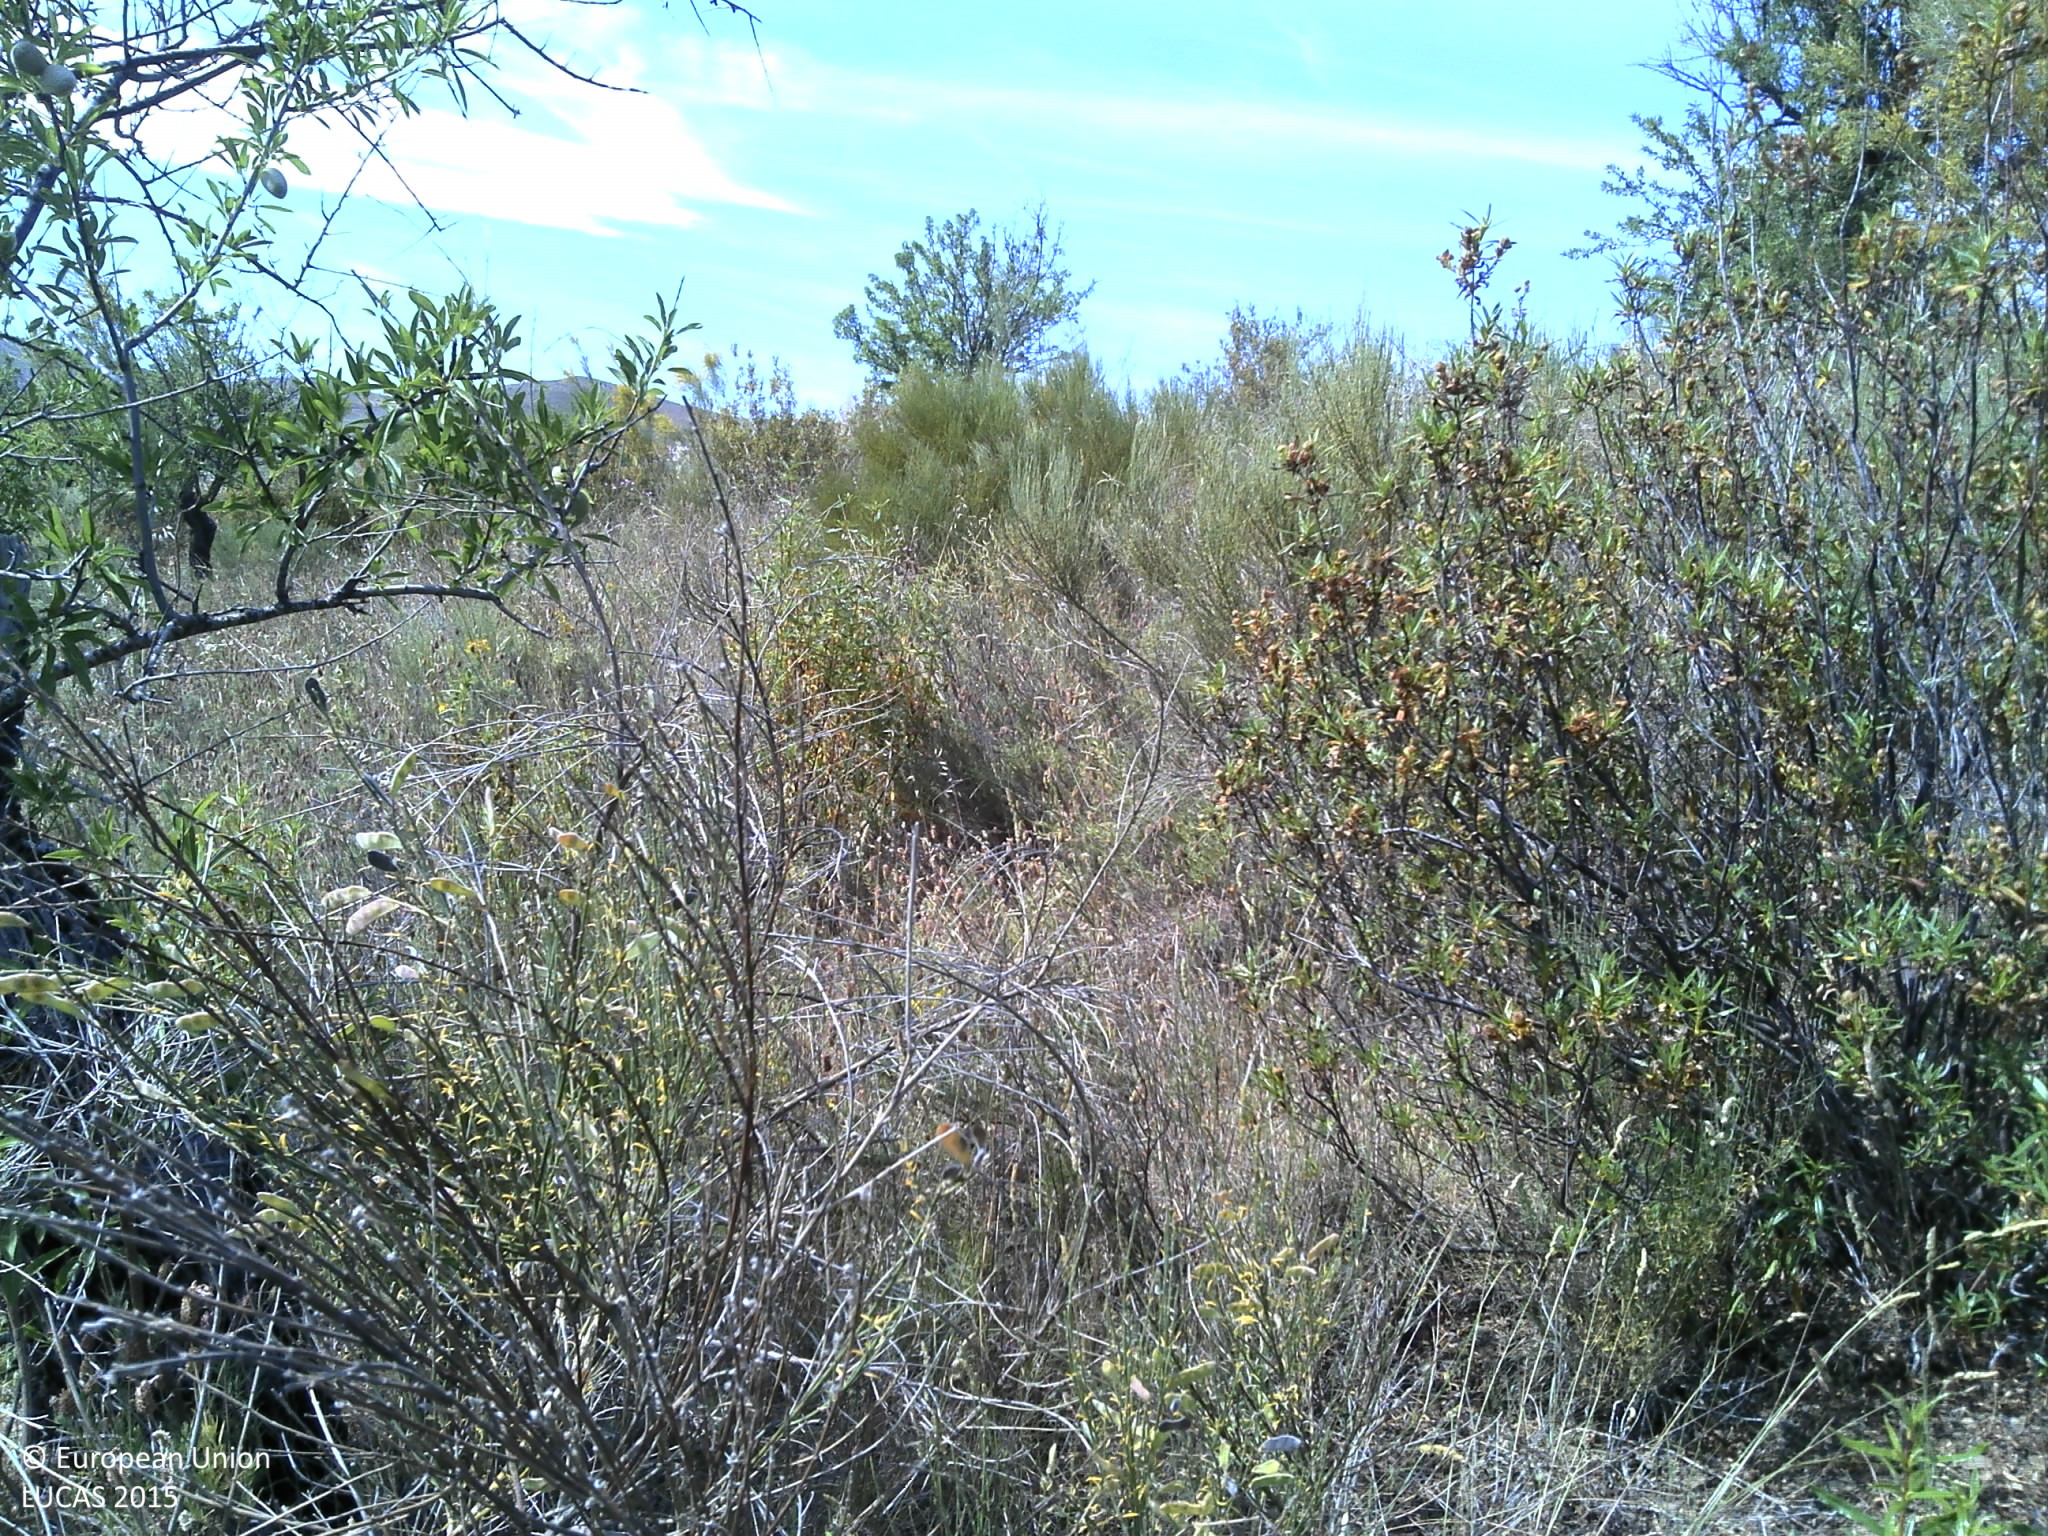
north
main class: Shrubland
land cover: Shrubland with sparse tree cover
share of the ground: 50 - 75 %
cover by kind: shrubs 75 %, unconsolidated bare surface 15 %, broadleaved forest trees 5 %, herbaceous plants 5 %
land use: Abandoned areas
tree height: < 5 m
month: May
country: PT
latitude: 41.2327
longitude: -6.9431
